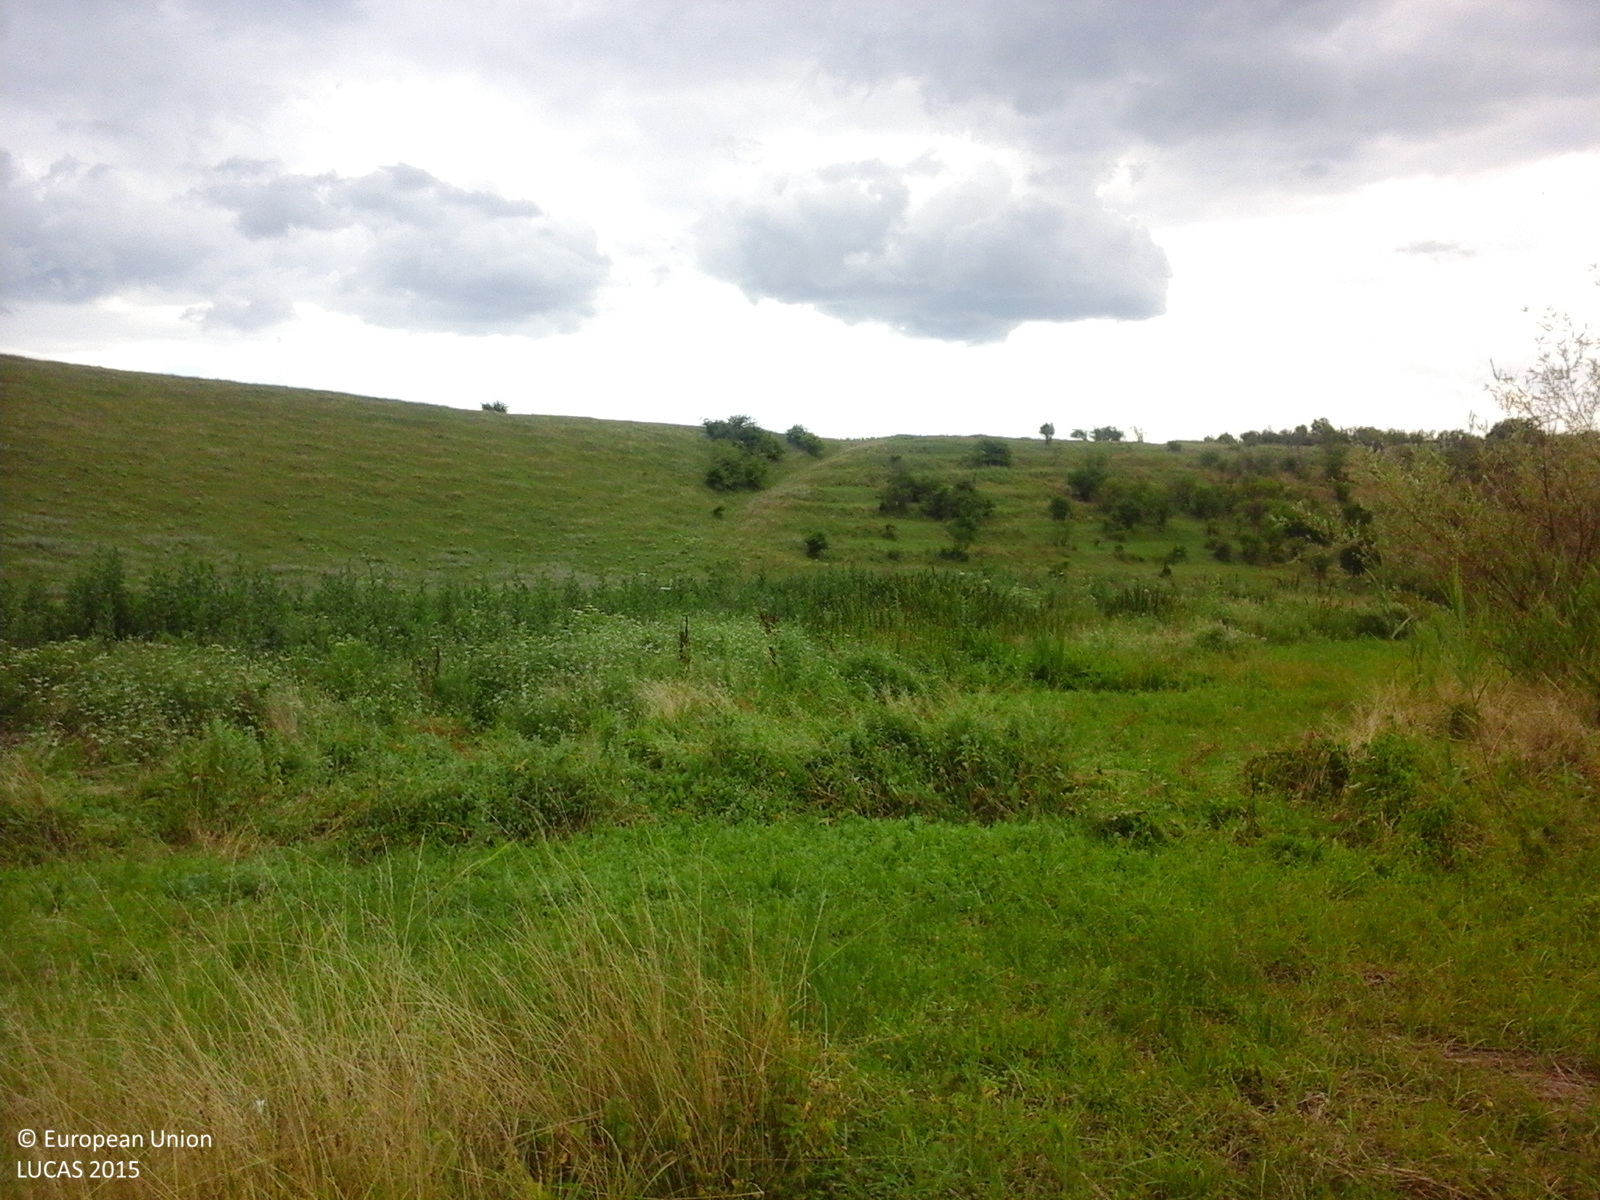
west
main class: Grassland
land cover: Grassland without tree/shrub cover
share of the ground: > 75 %
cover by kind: herbaceous plants 100 %
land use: Agriculture (excluding fallow land and kitchen gardens)
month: July
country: RO
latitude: 44.0143
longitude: 24.8041
